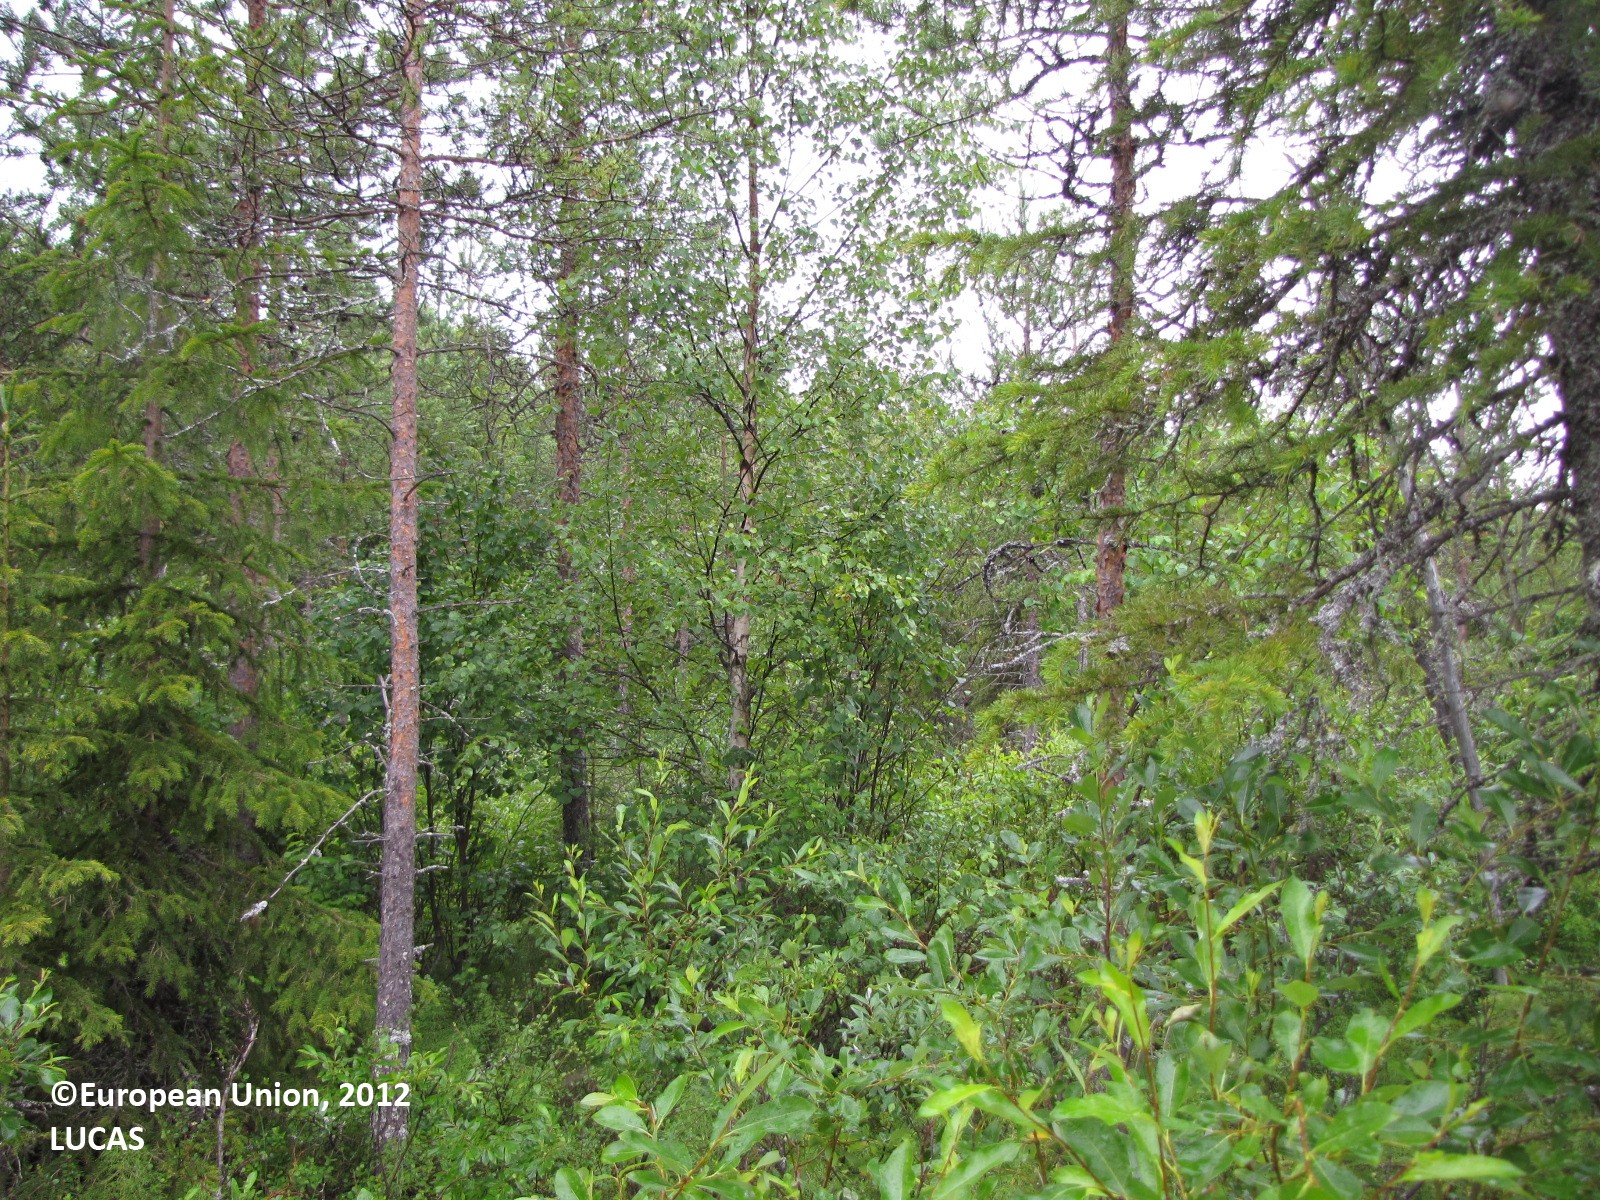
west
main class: Woodland
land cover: Other mixed woodland
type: boreal forest
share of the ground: 50 - 75 %
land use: Forestry
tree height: > 5 m
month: July
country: FI
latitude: 66.6220
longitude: 24.7499
